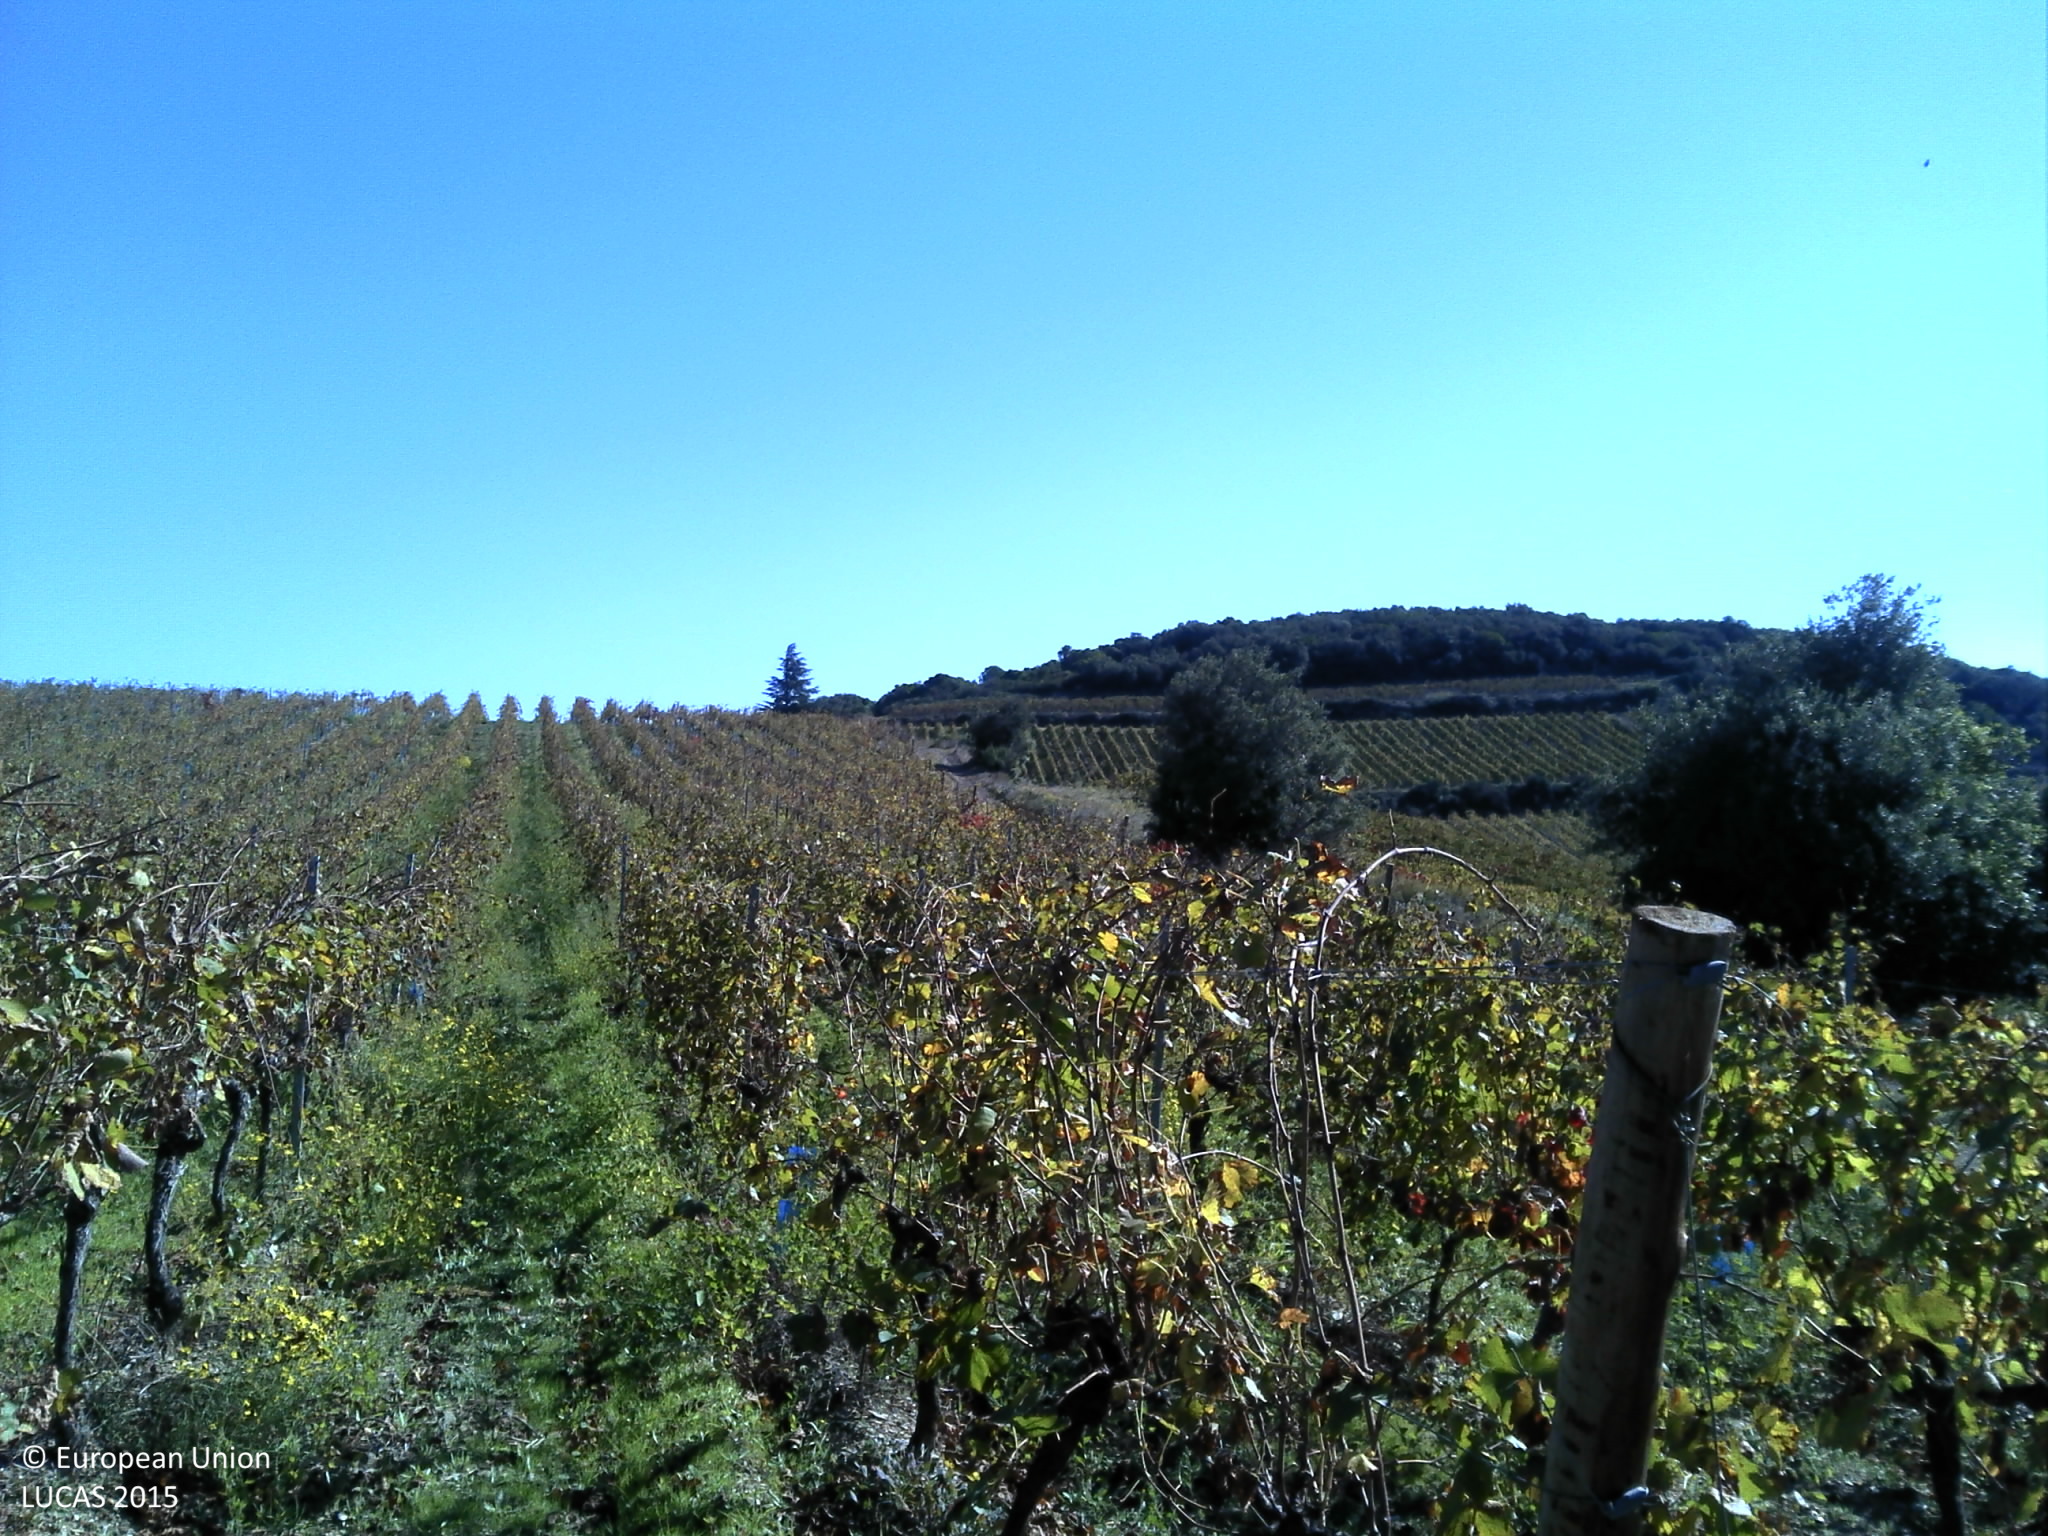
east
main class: Cropland
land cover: Vineyards
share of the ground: 10 - 25 %
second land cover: Spontaneously vegetated surfaces
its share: > 75 %
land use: Agriculture (excluding fallow land and kitchen gardens)
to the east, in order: Vineyards; Spontaneously vegetated surfaces; Tracks; Grass margins; Broadleaved woodland; Tracks; Shruby margins; Tracks; Vineyards
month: October
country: FR
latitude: 43.5246
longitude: 3.1169
